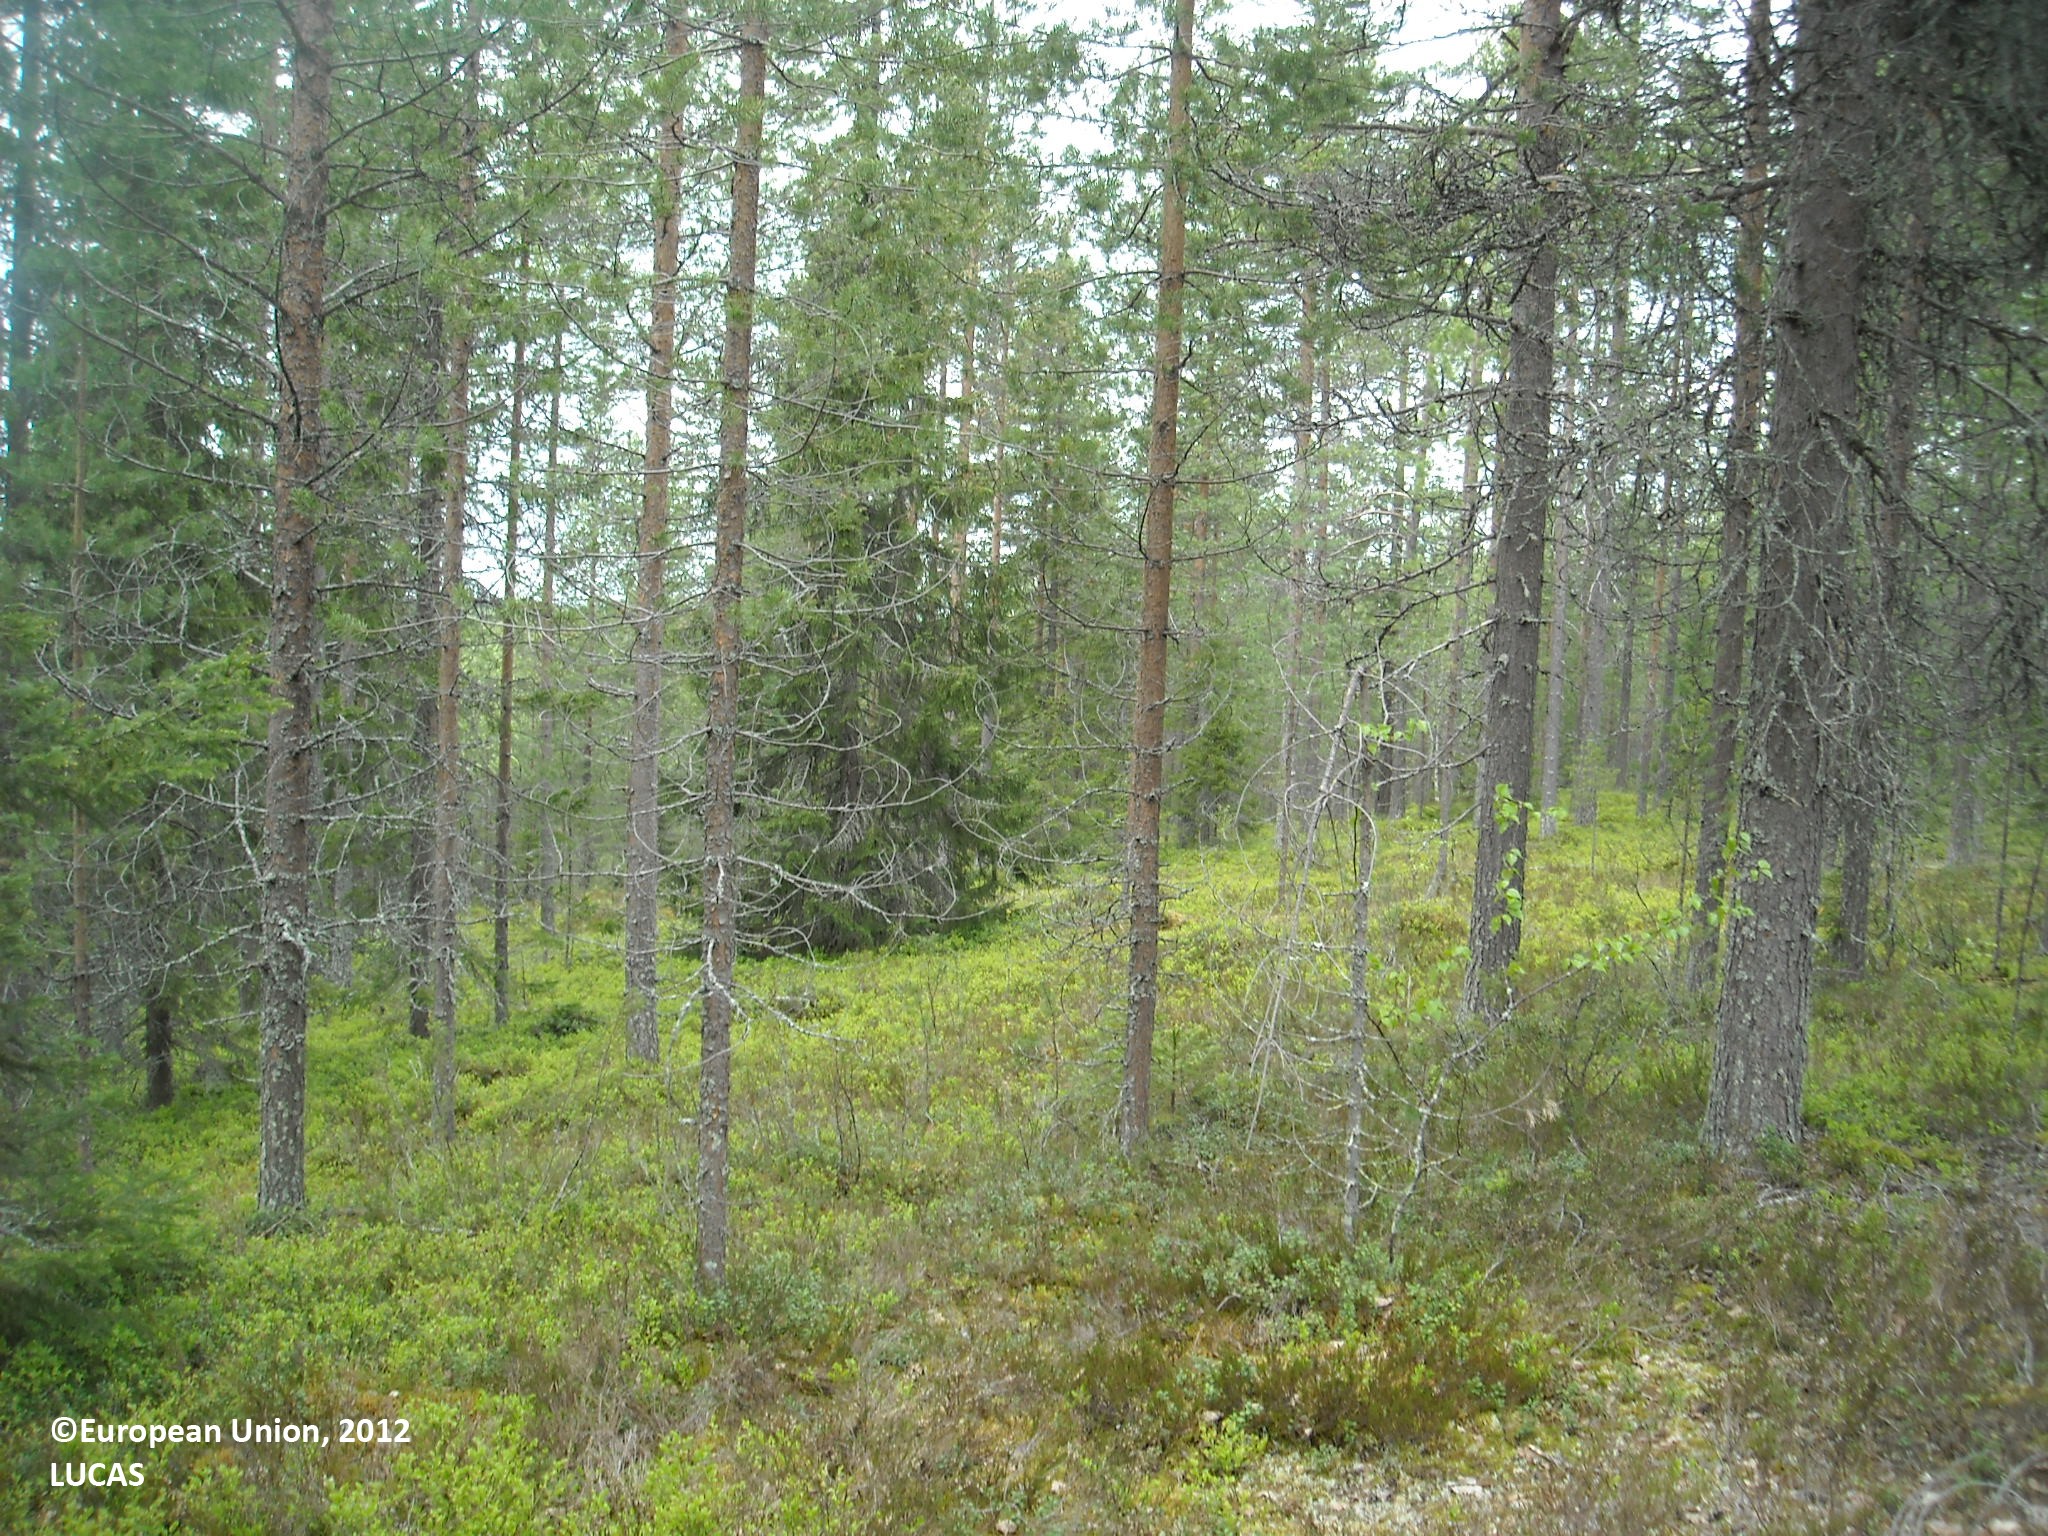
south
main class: Woodland
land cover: Other coniferous woodland
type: boreal forest
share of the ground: 50 - 75 %
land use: Forestry
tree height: > 5 m
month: June
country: FI
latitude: 65.2773
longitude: 27.8213
